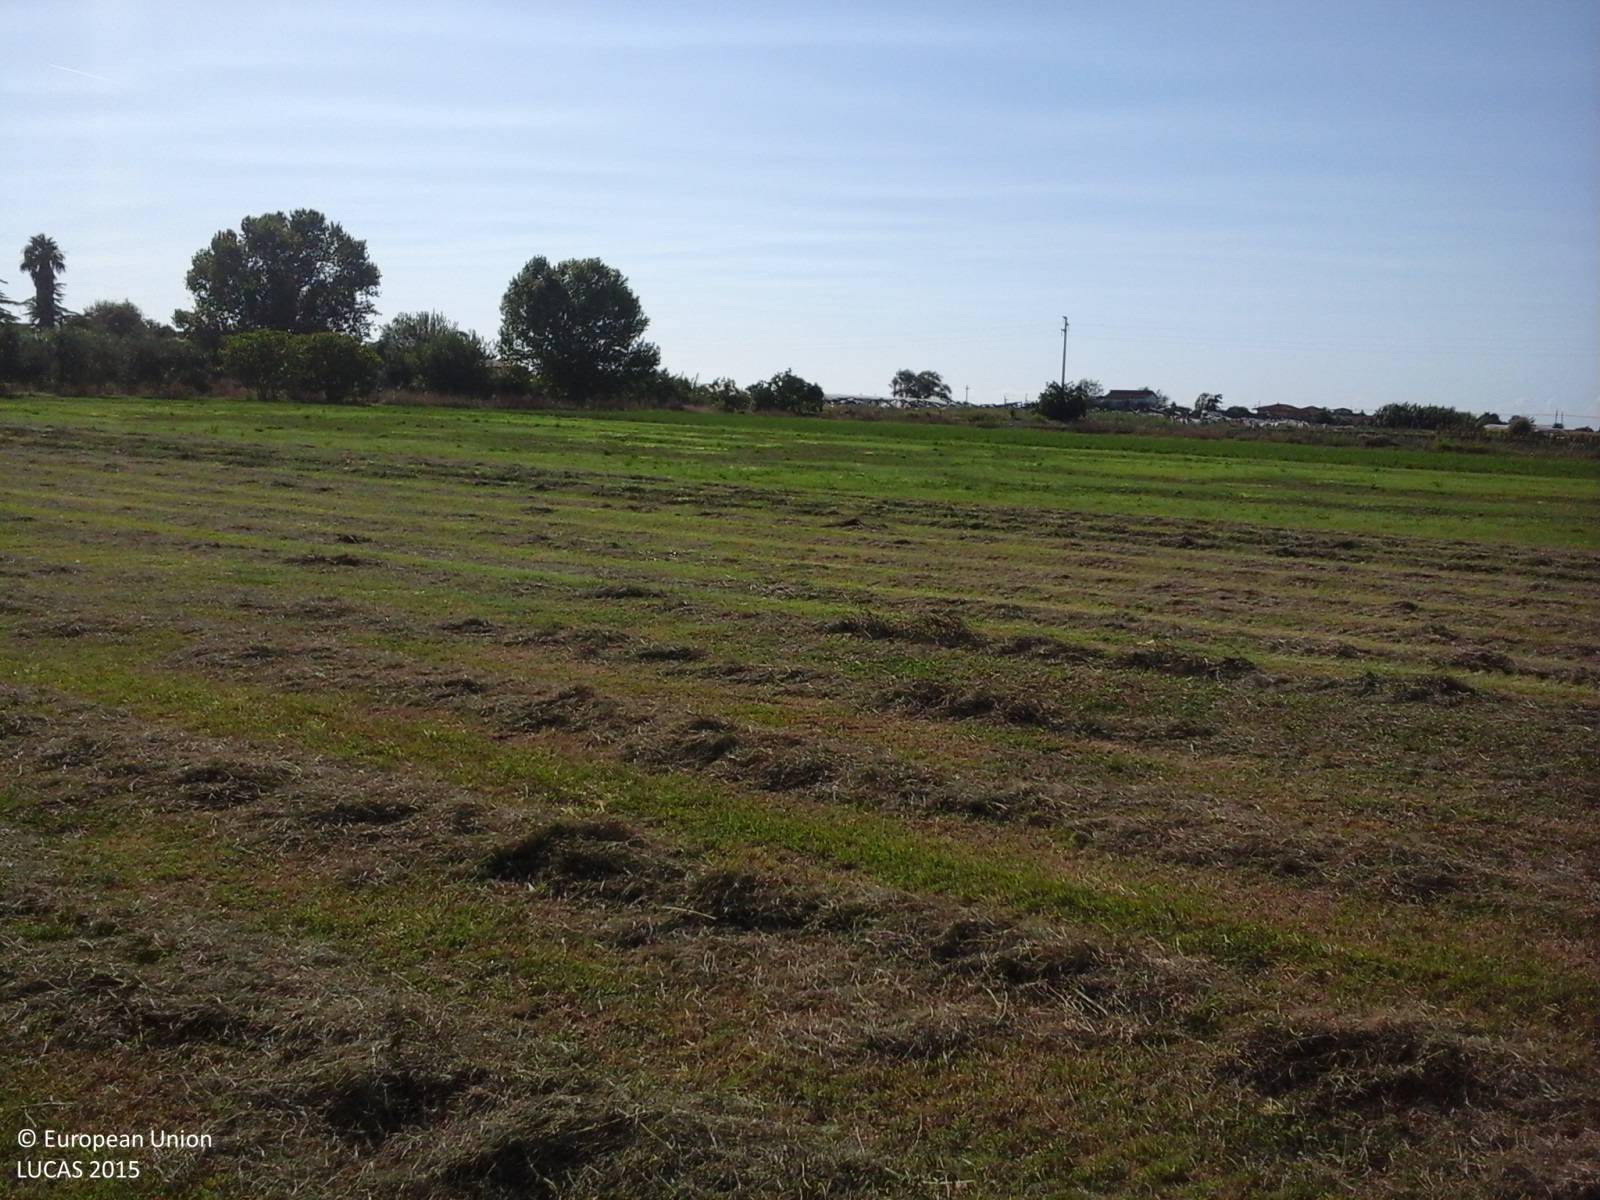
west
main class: Cropland
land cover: Temporary grasslands
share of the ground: > 75 %
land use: Agriculture (excluding fallow land and kitchen gardens)
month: August
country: IT
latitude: 41.4324
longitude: 13.0633
